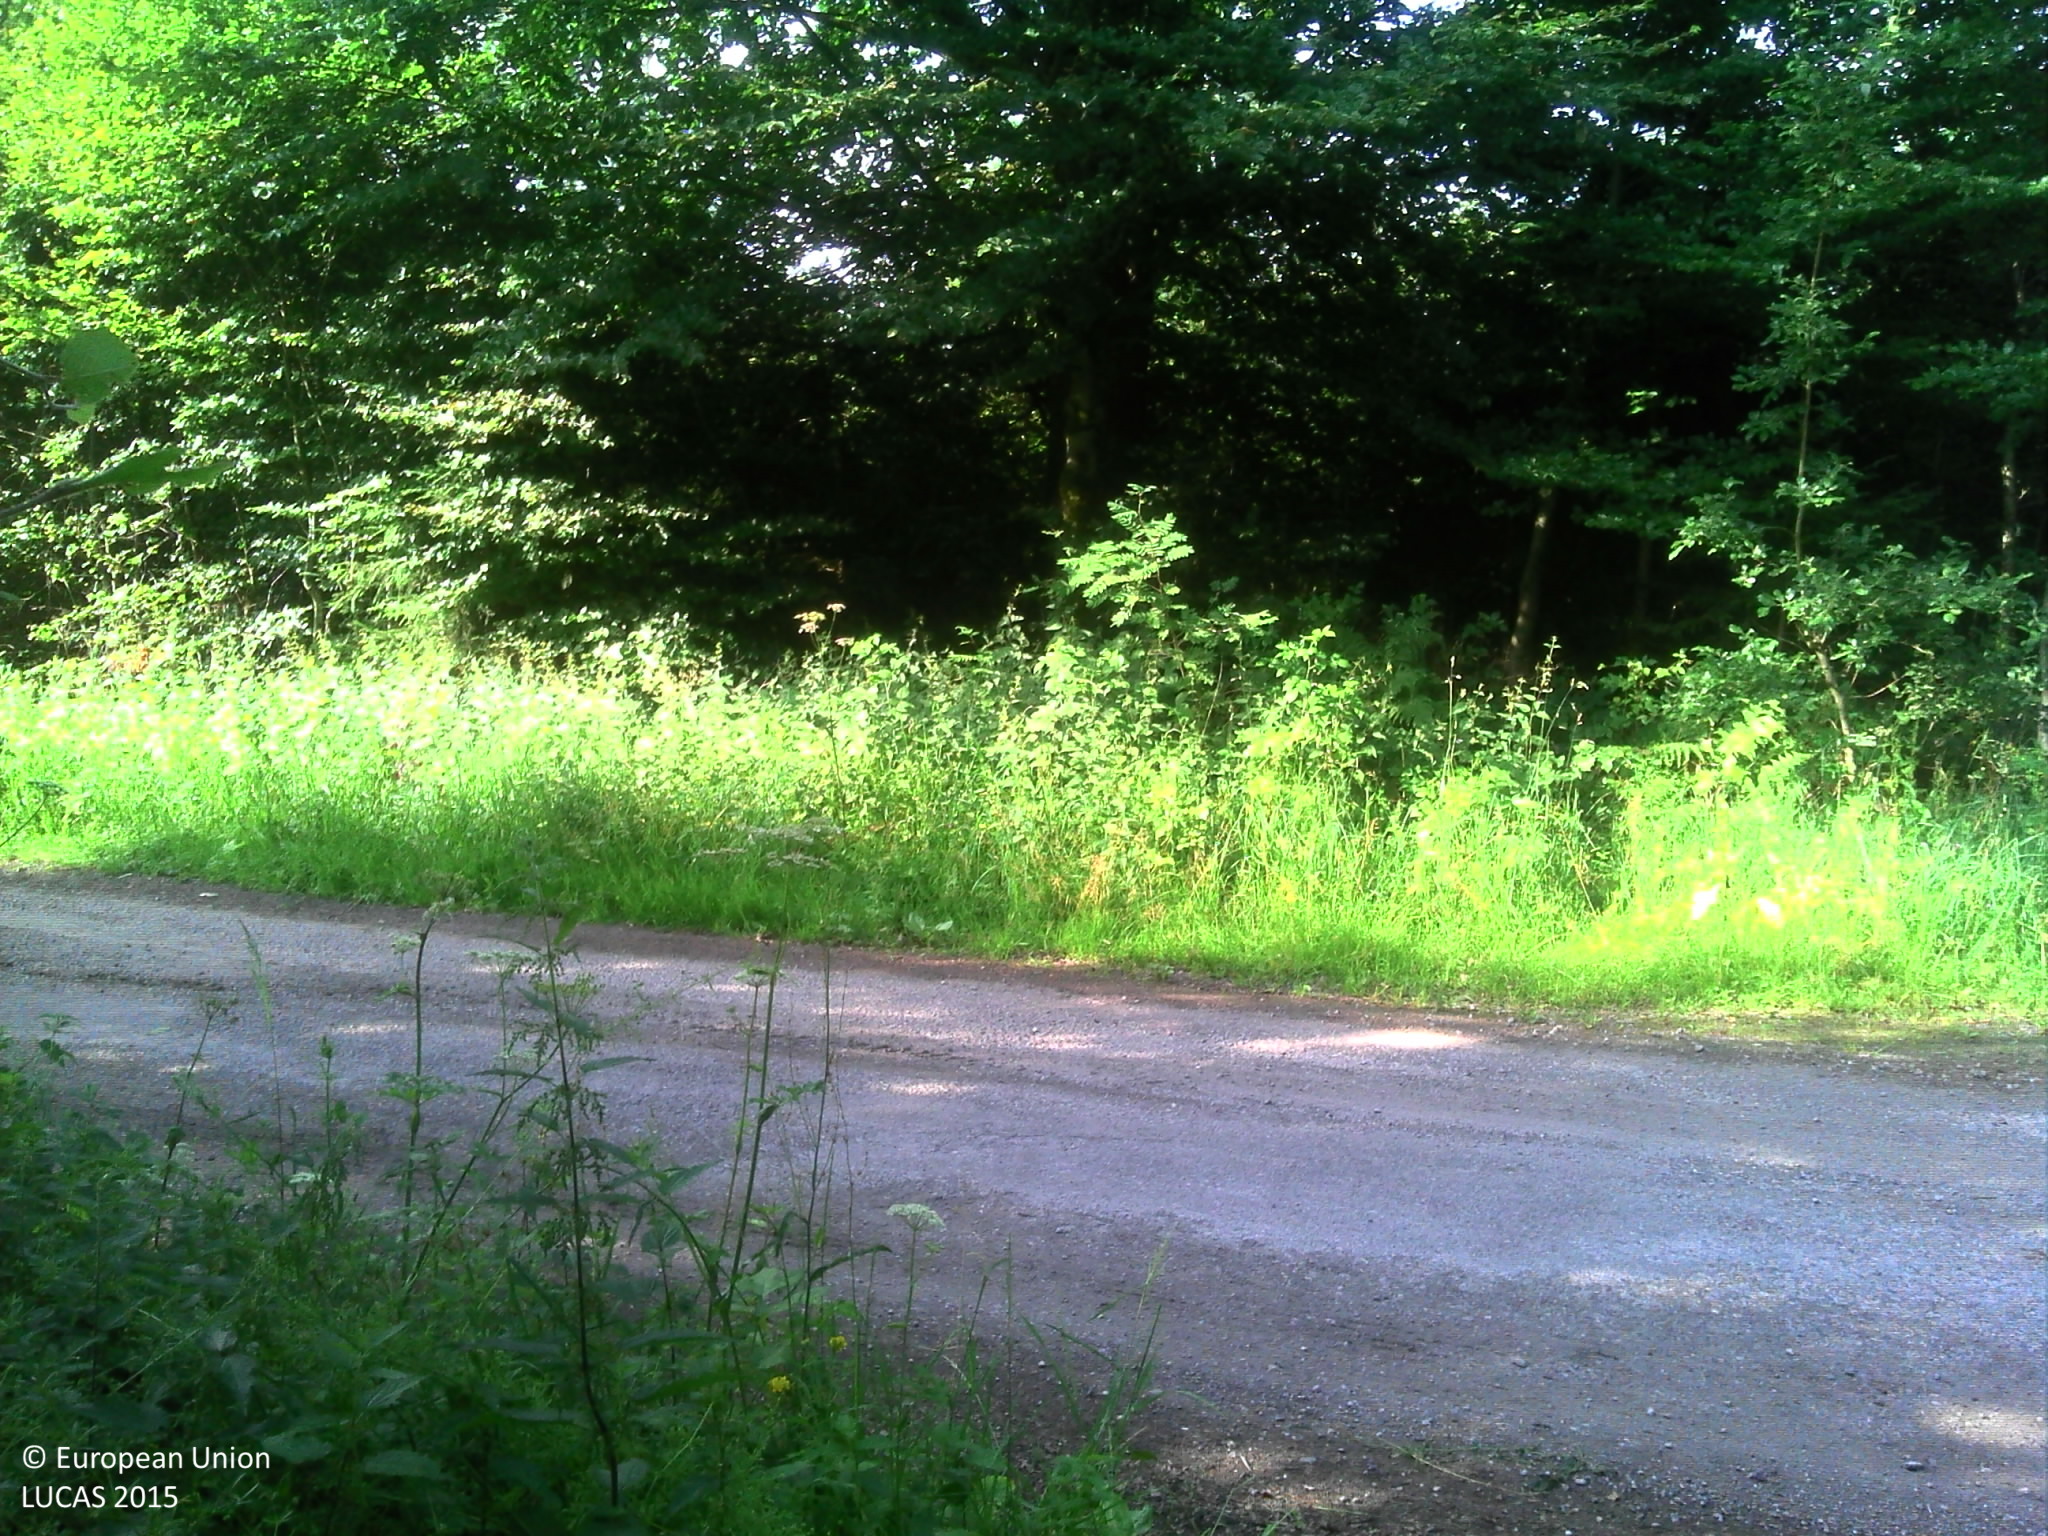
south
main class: Woodland
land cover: Broadleaved woodland
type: acidophilous oak and oak-birch forest
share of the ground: > 75 %
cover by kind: broadleaved forest trees 80 %, herbaceous plants 15 %, shrubs 5 %
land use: Forestry
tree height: > 5 m
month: July
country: BE
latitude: 49.9355
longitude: 5.5540
